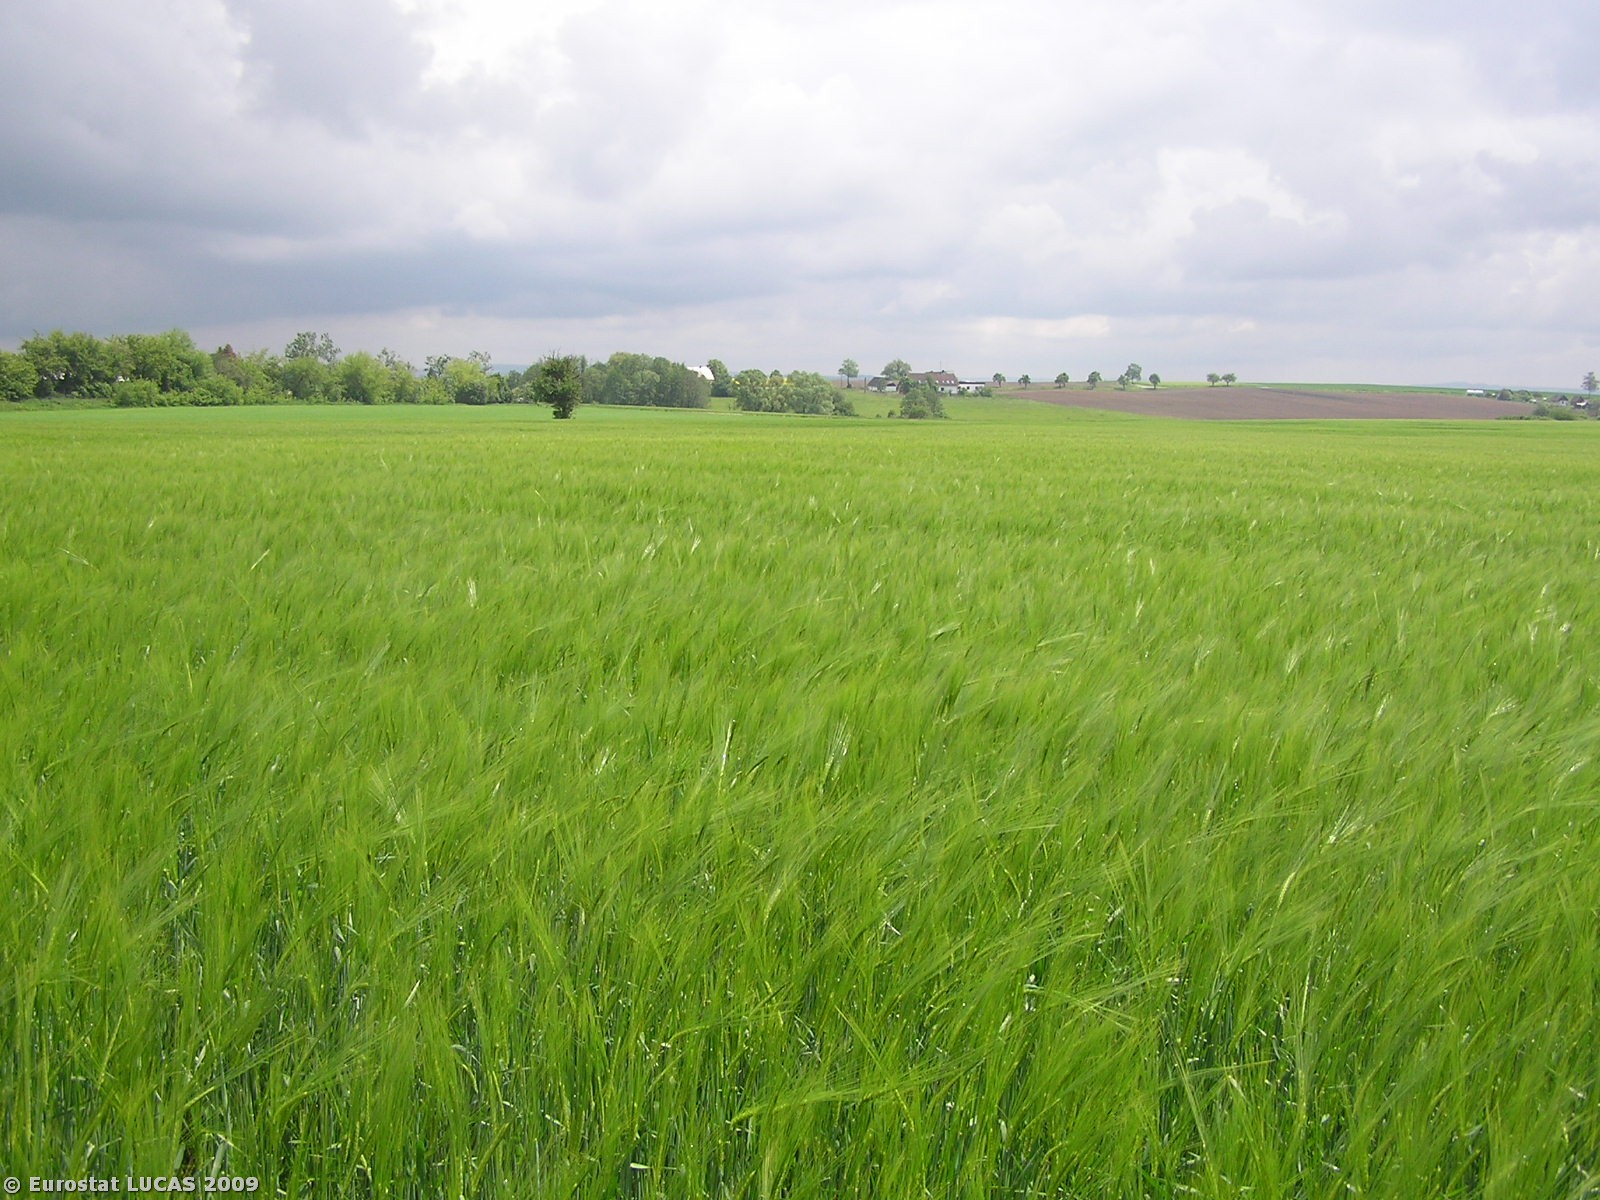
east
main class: Cropland
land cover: Barley
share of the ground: > 75 %
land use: Agriculture (excluding fallow land and kitchen gardens)
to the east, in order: Barley
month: May
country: CZ
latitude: 49.4432
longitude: 14.5943
